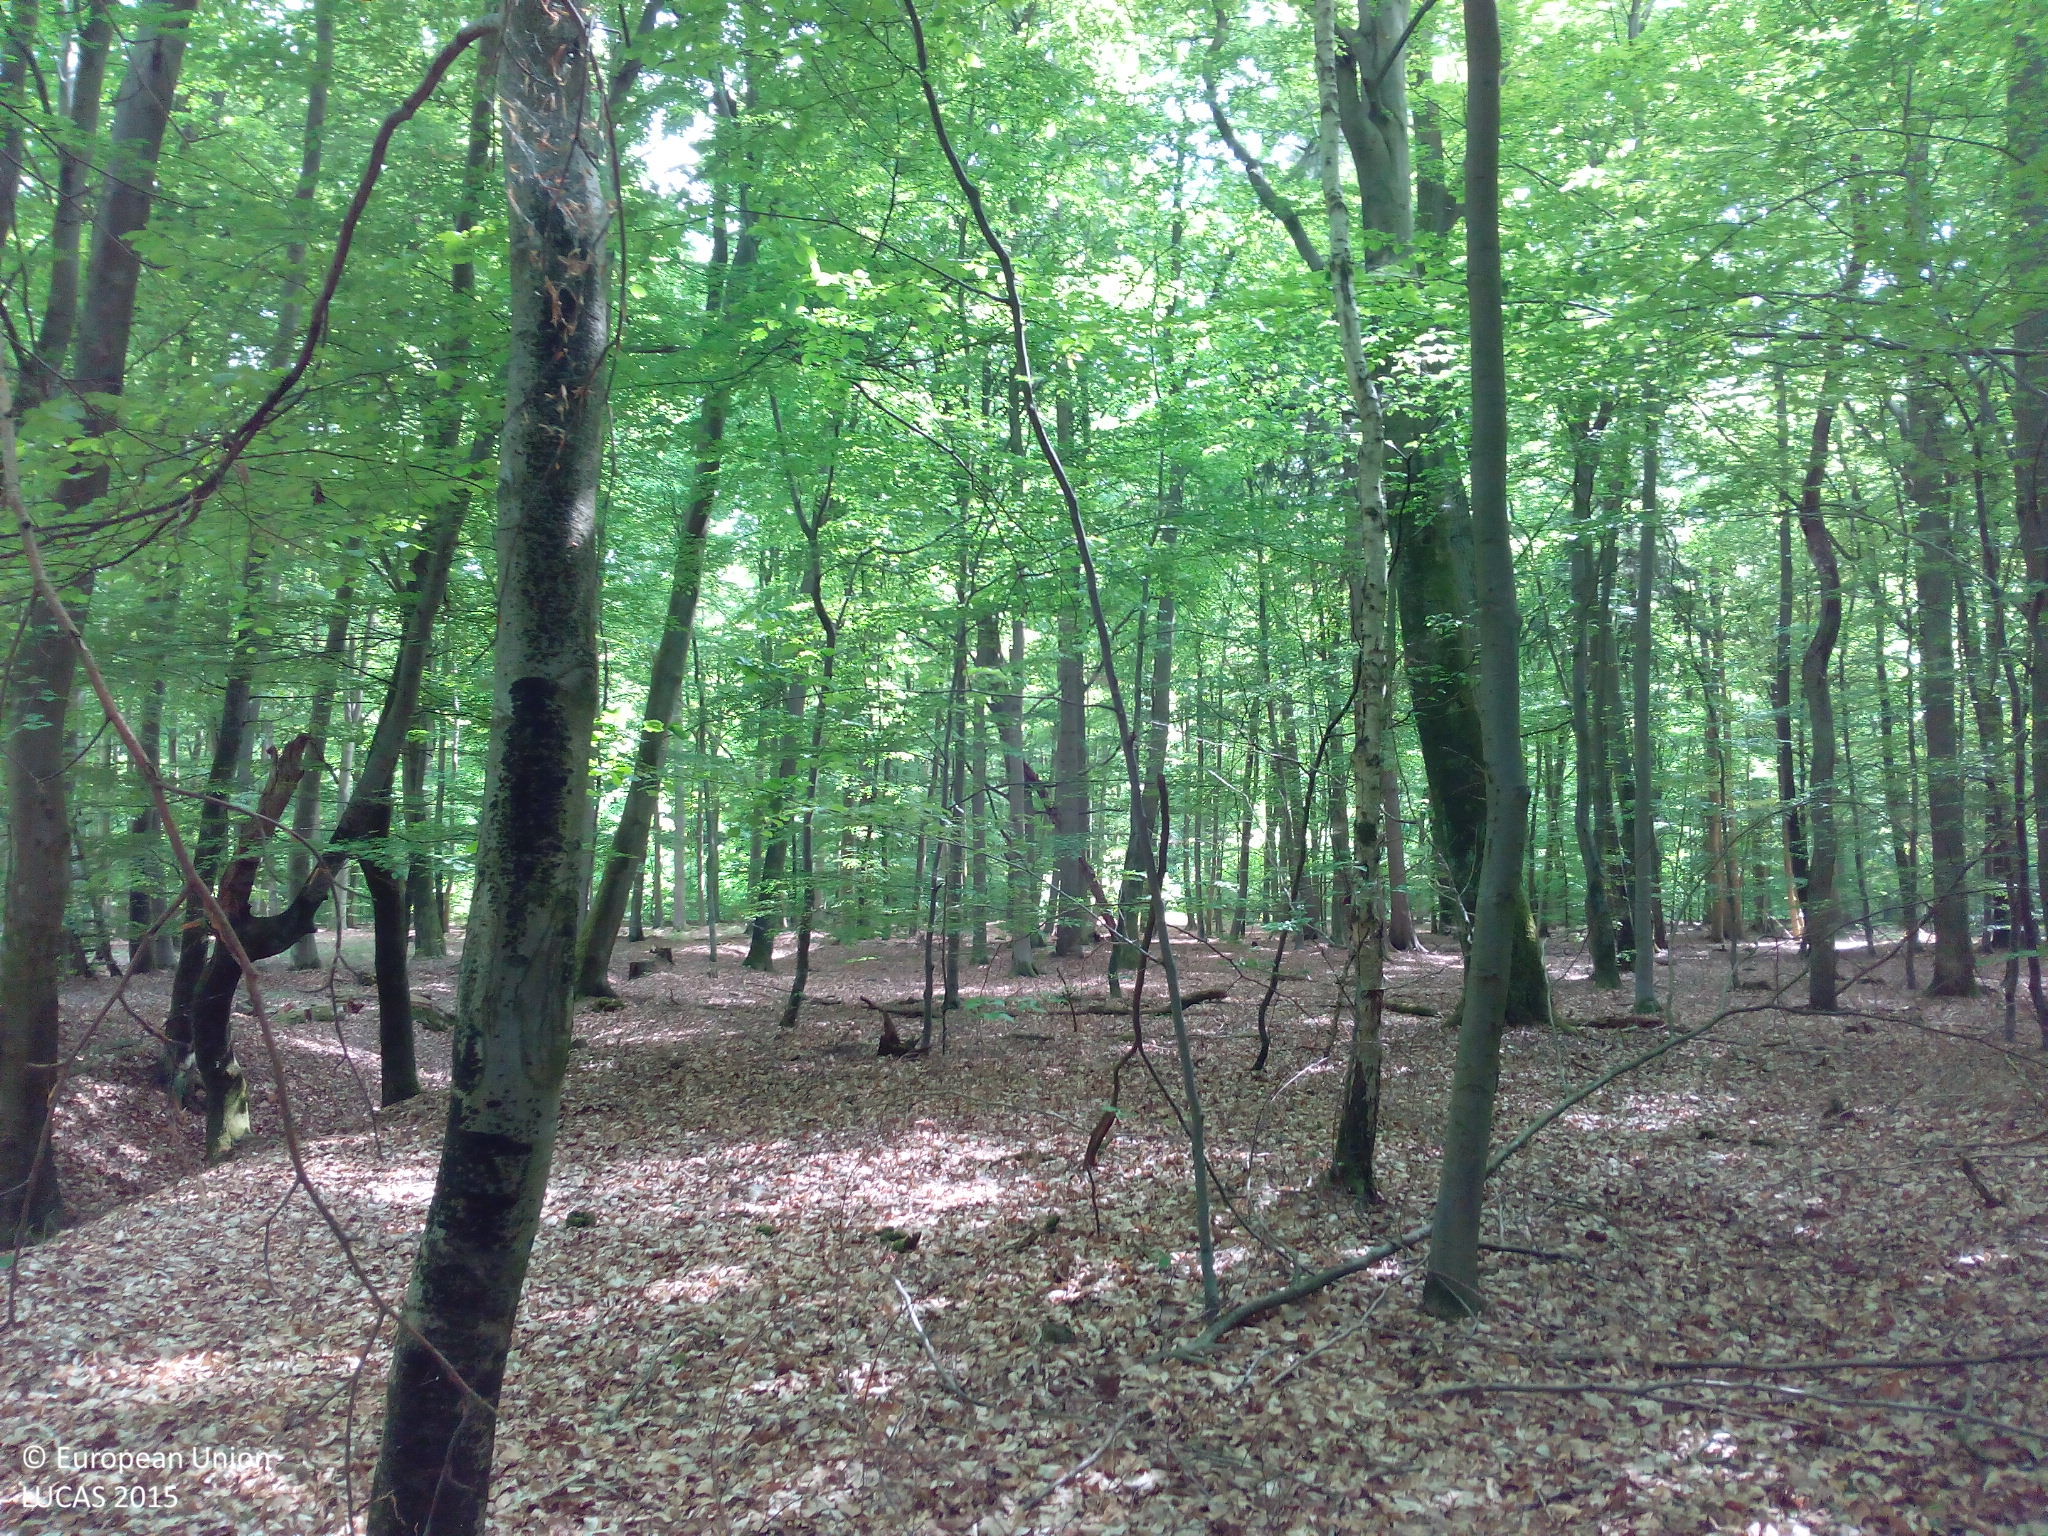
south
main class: Woodland
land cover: Broadleaved woodland
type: beech forest
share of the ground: 25 - 50 %
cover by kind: broadleaved forest trees 80 %, unconsolidated bare surface 20 %
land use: Forestry
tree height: > 5 m
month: May
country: DE
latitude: 53.4987
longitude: 11.6425
